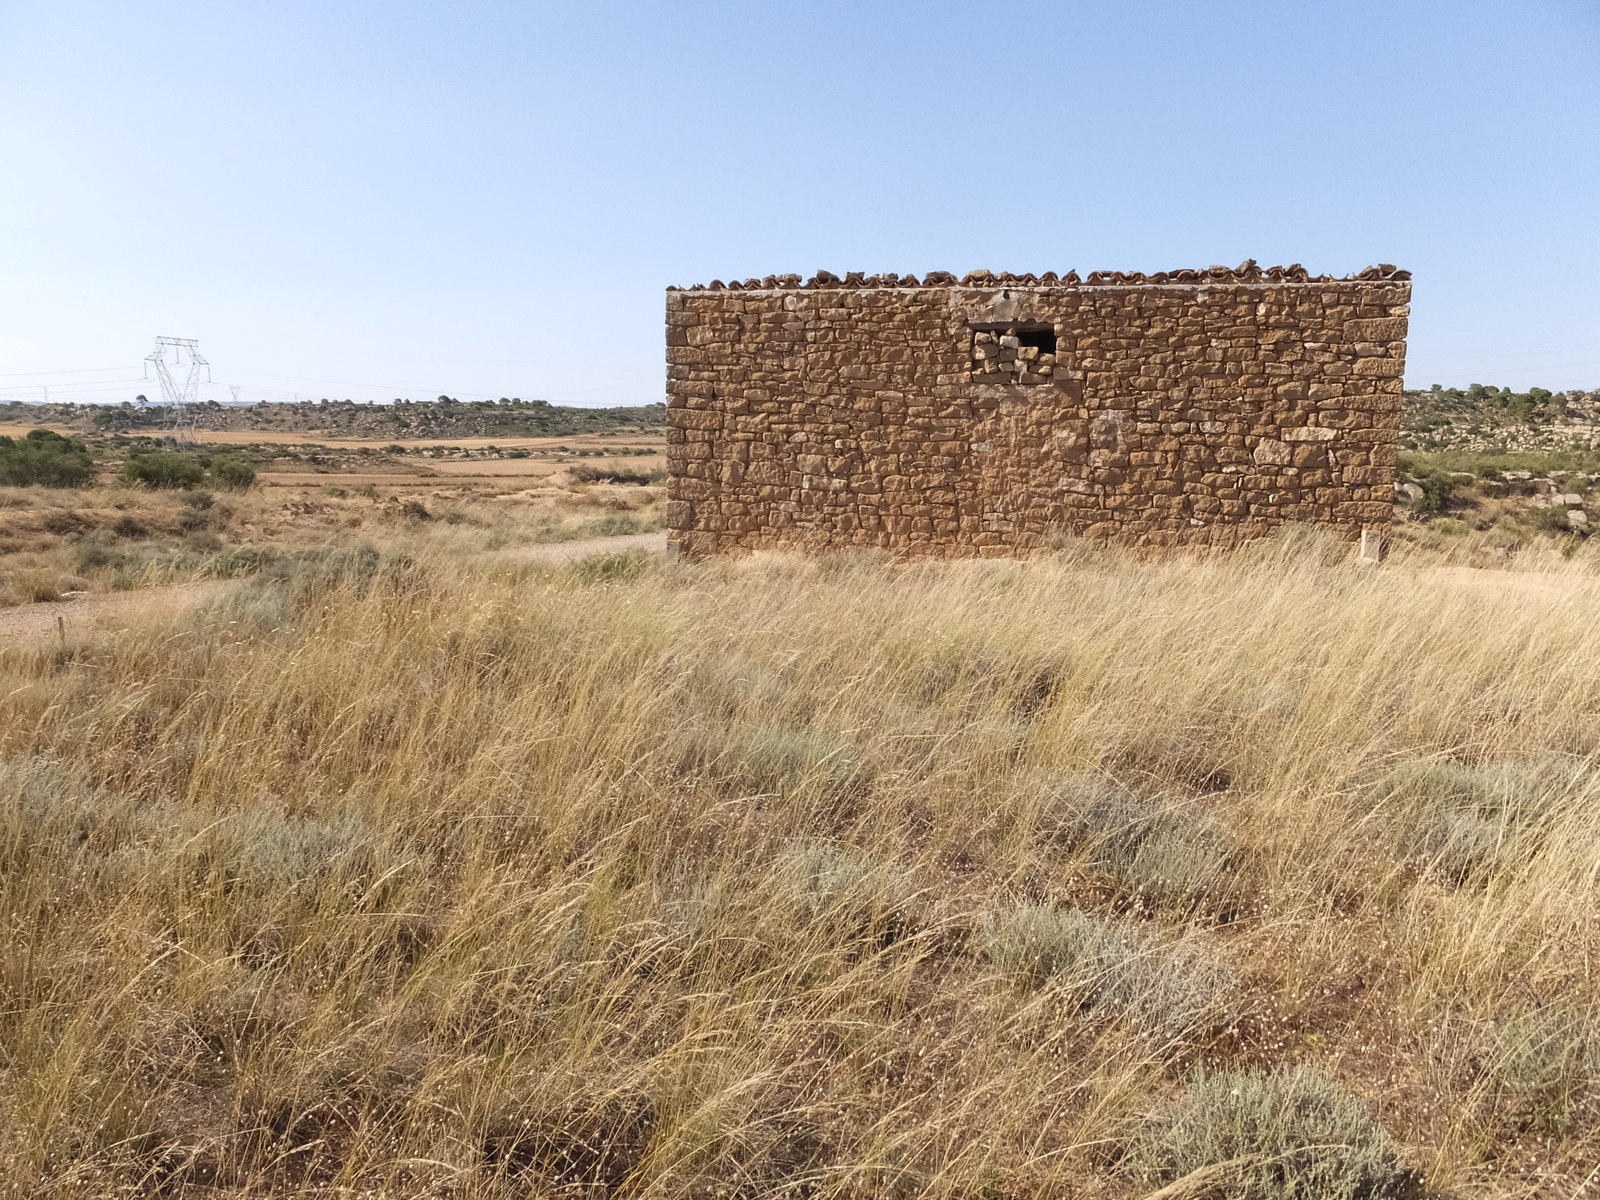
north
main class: Grassland
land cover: Grassland without tree/shrub cover
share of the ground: > 75 %
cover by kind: herbaceous plants 50 %, consolidated bare surface 50 %
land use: Semi-natural and natural areas not in use
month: June
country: ES
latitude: 41.2445
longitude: -0.2161
